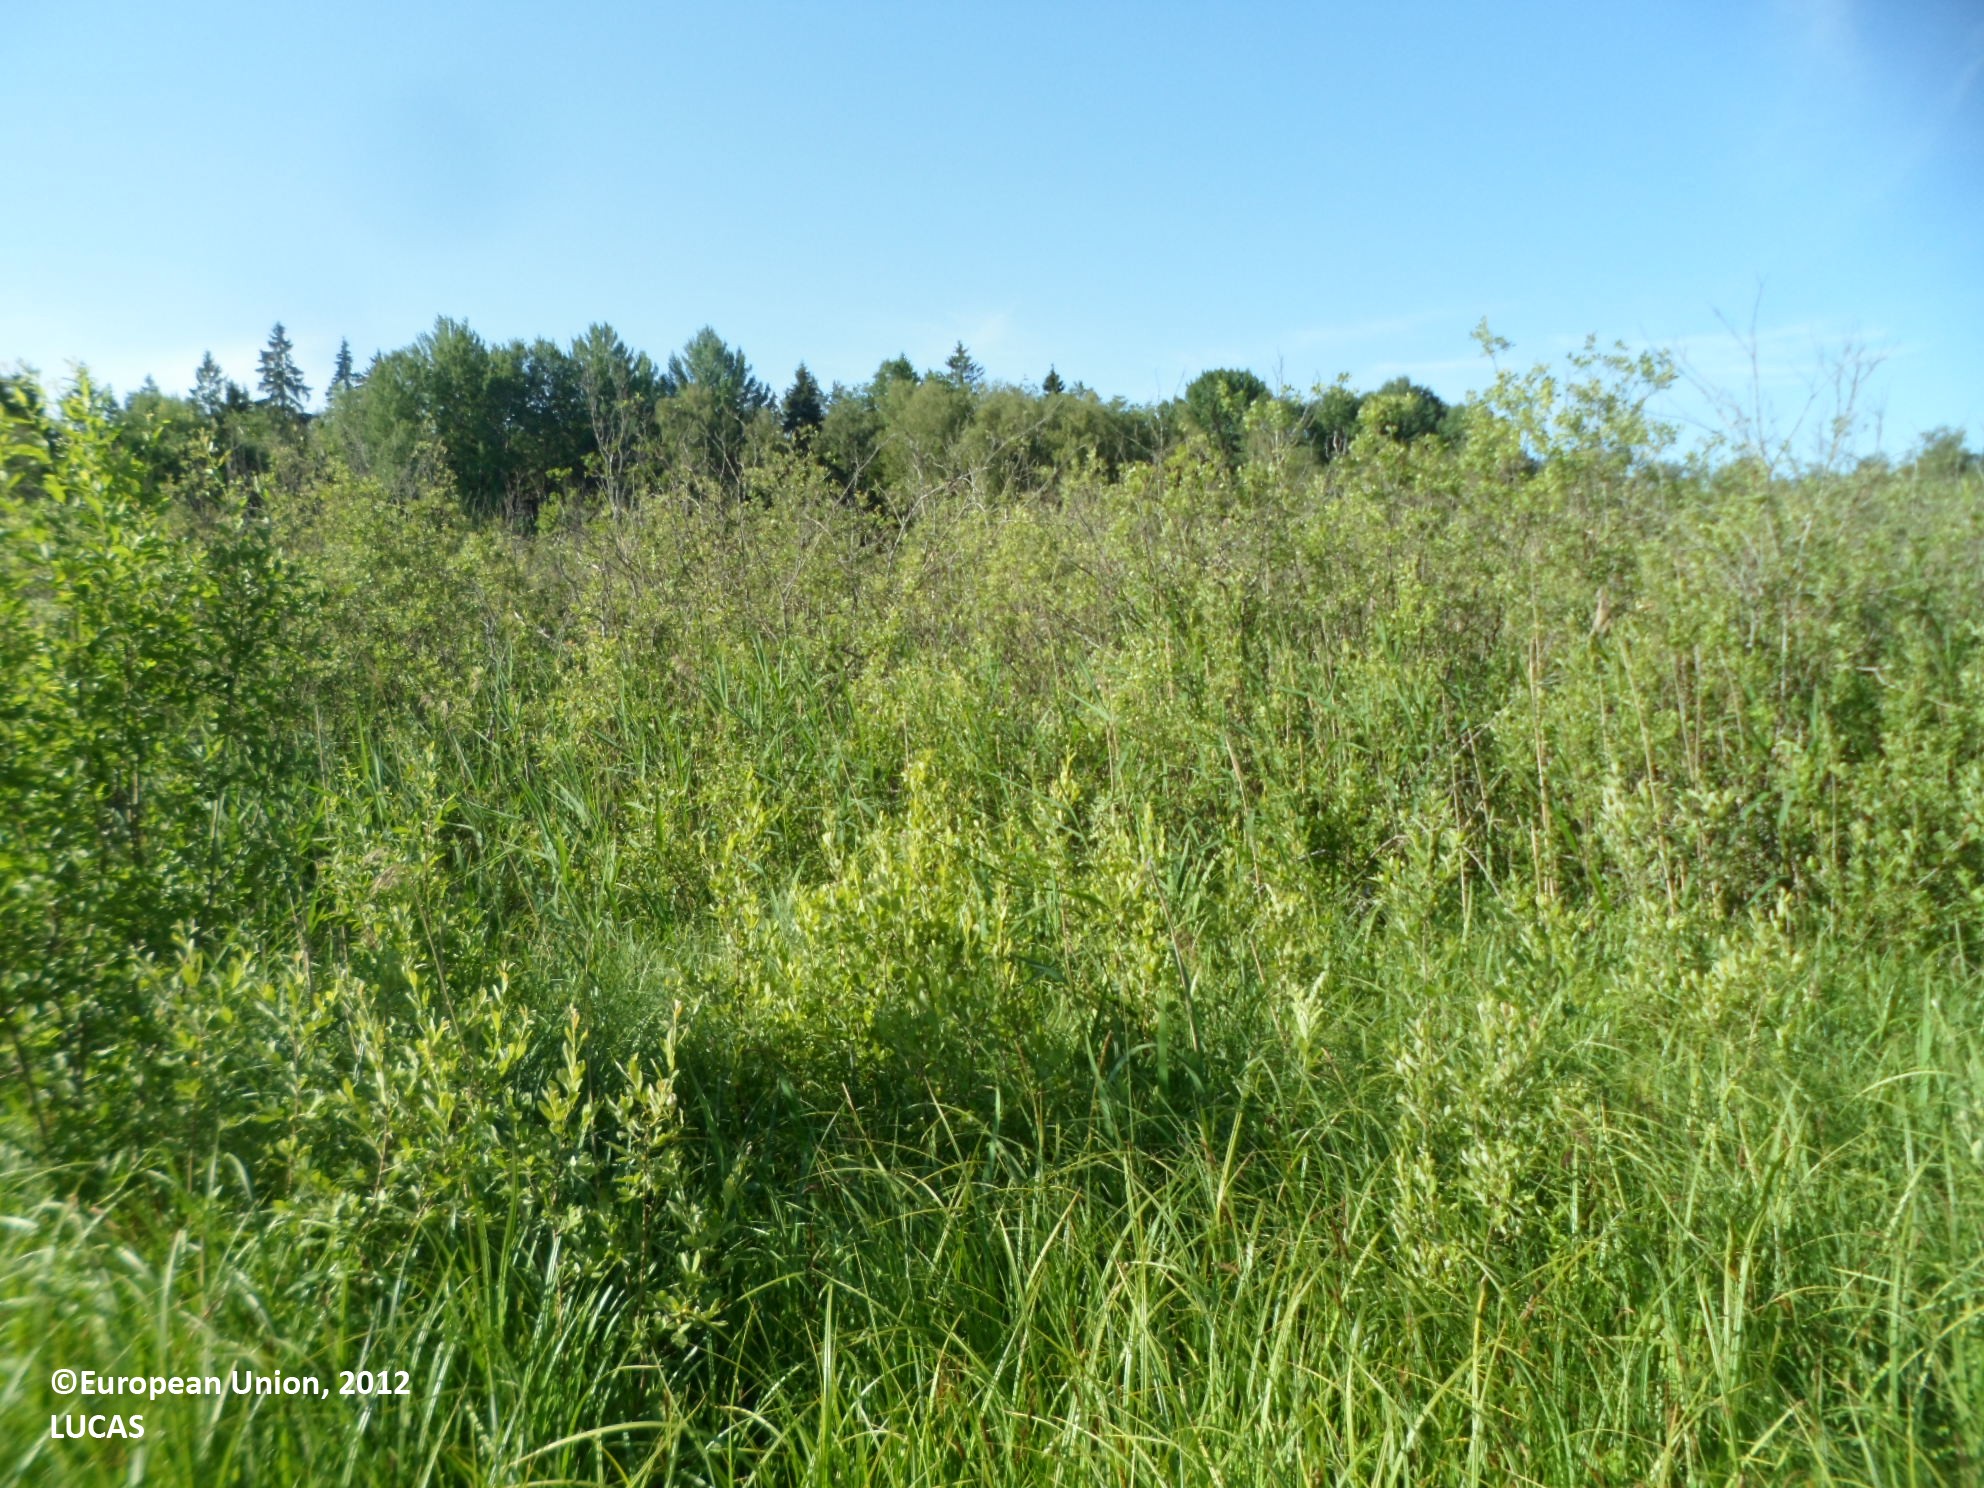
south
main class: Shrubland
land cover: Shrubland with sparse tree cover
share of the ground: > 75 %
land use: Semi-natural and natural areas not in use
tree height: > 5 m
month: July
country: SE
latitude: 59.3246
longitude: 18.5241
